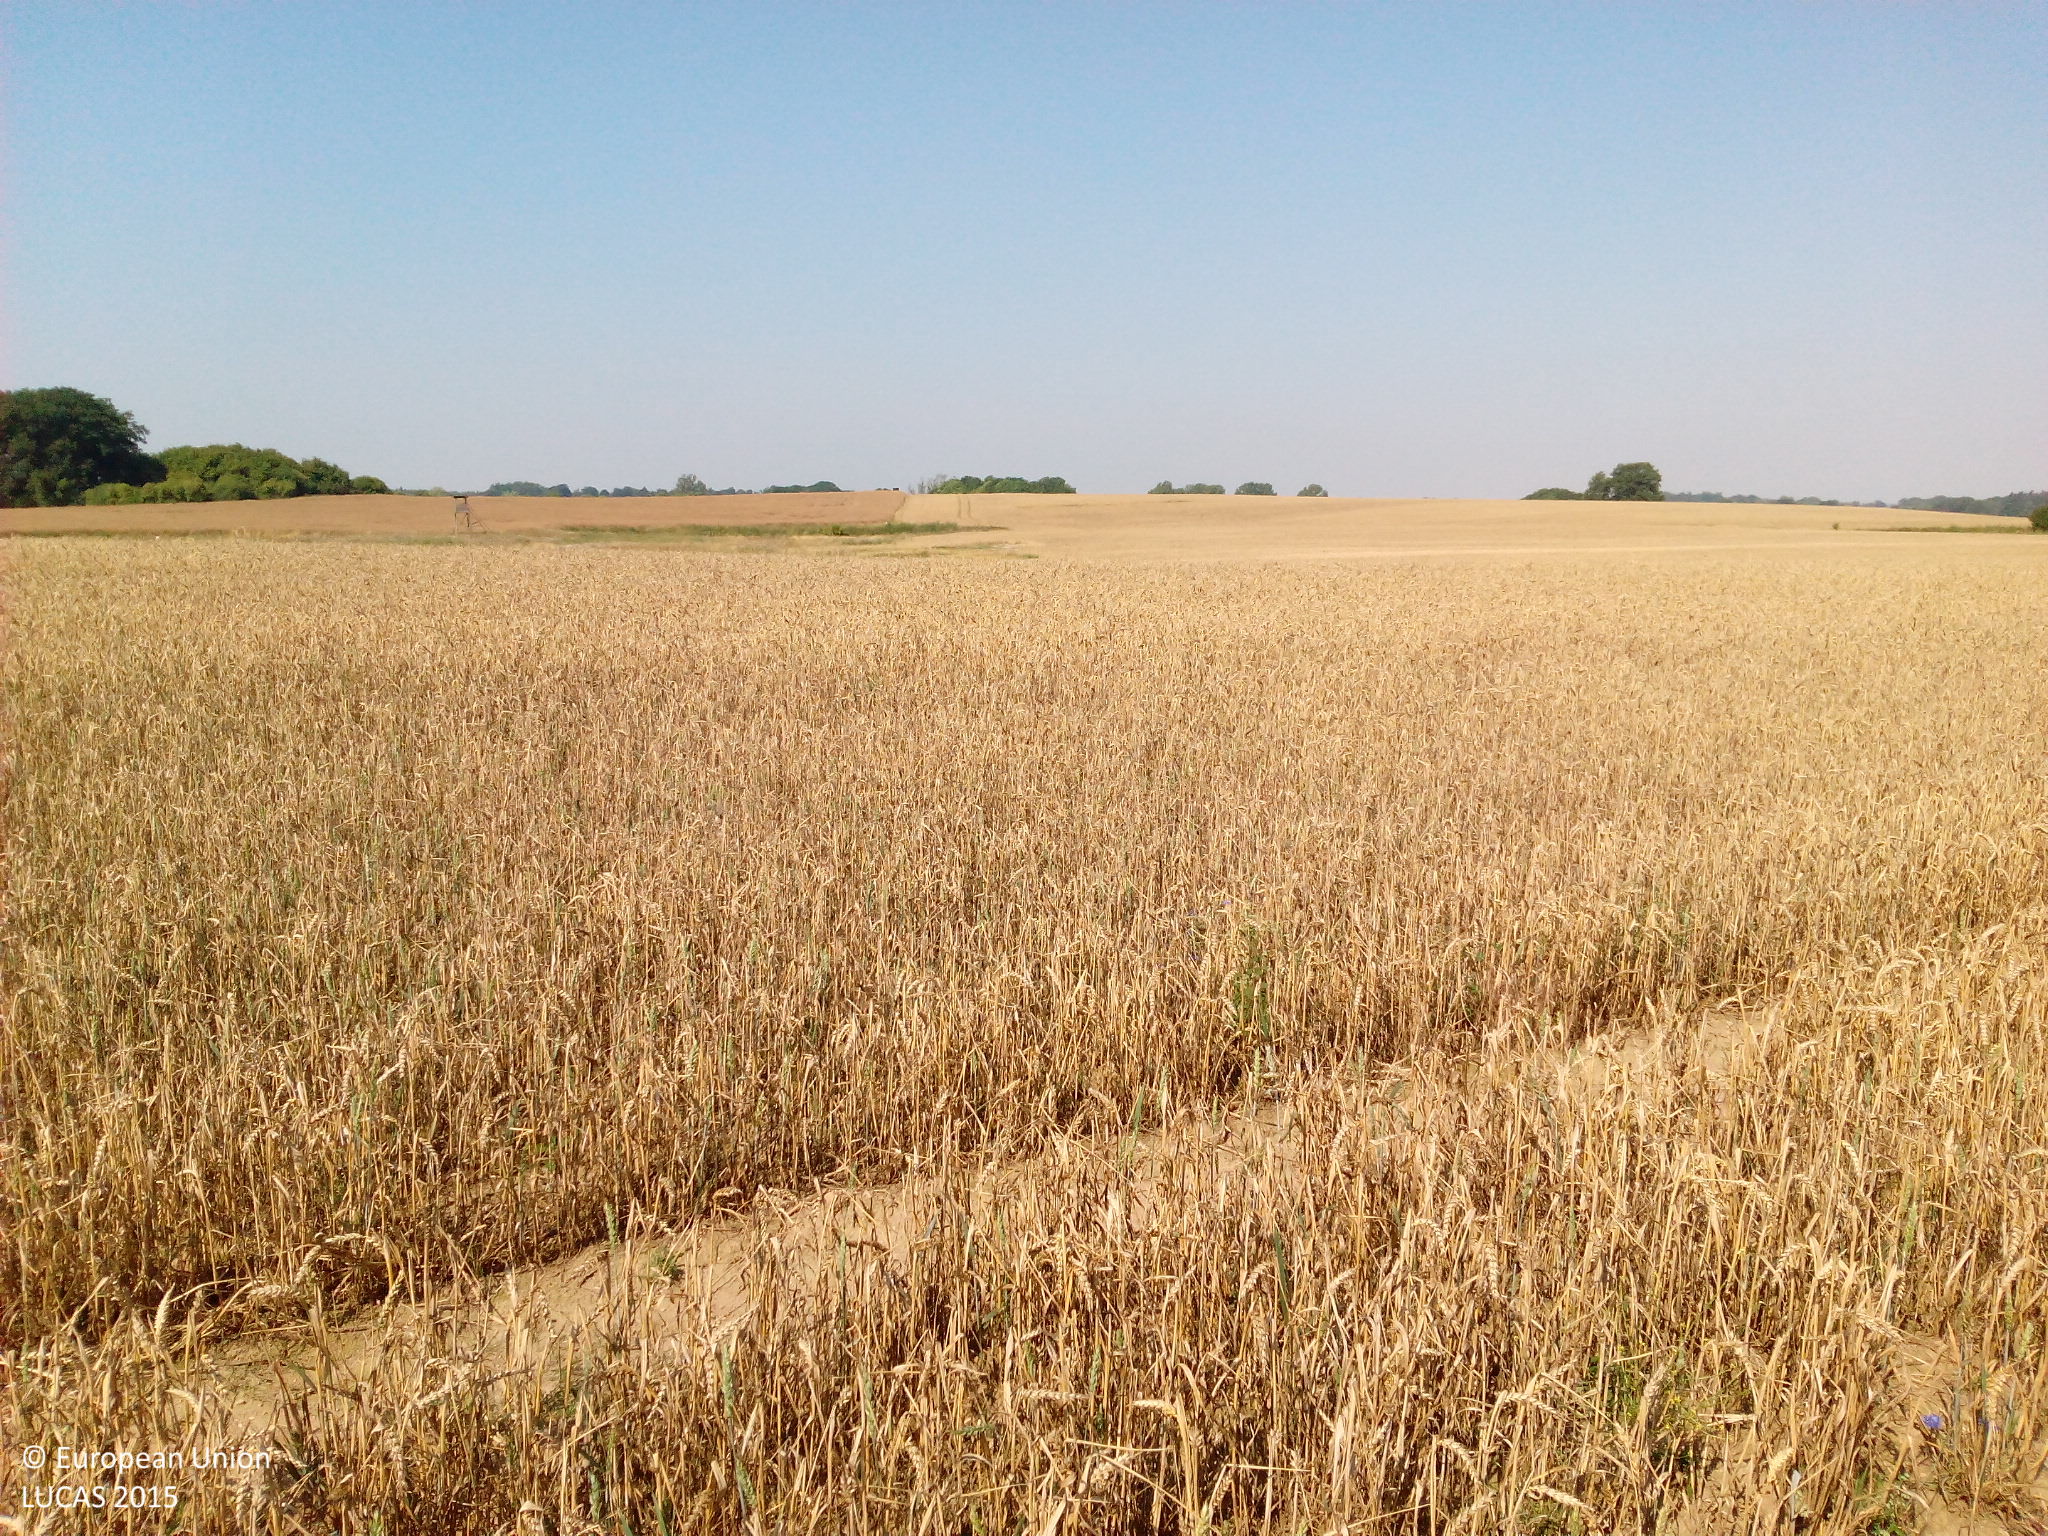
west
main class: Cropland
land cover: Common wheat
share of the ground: 25 - 50 %
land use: Agriculture (excluding fallow land and kitchen gardens)
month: August
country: DE
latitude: 53.2949
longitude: 13.5857
